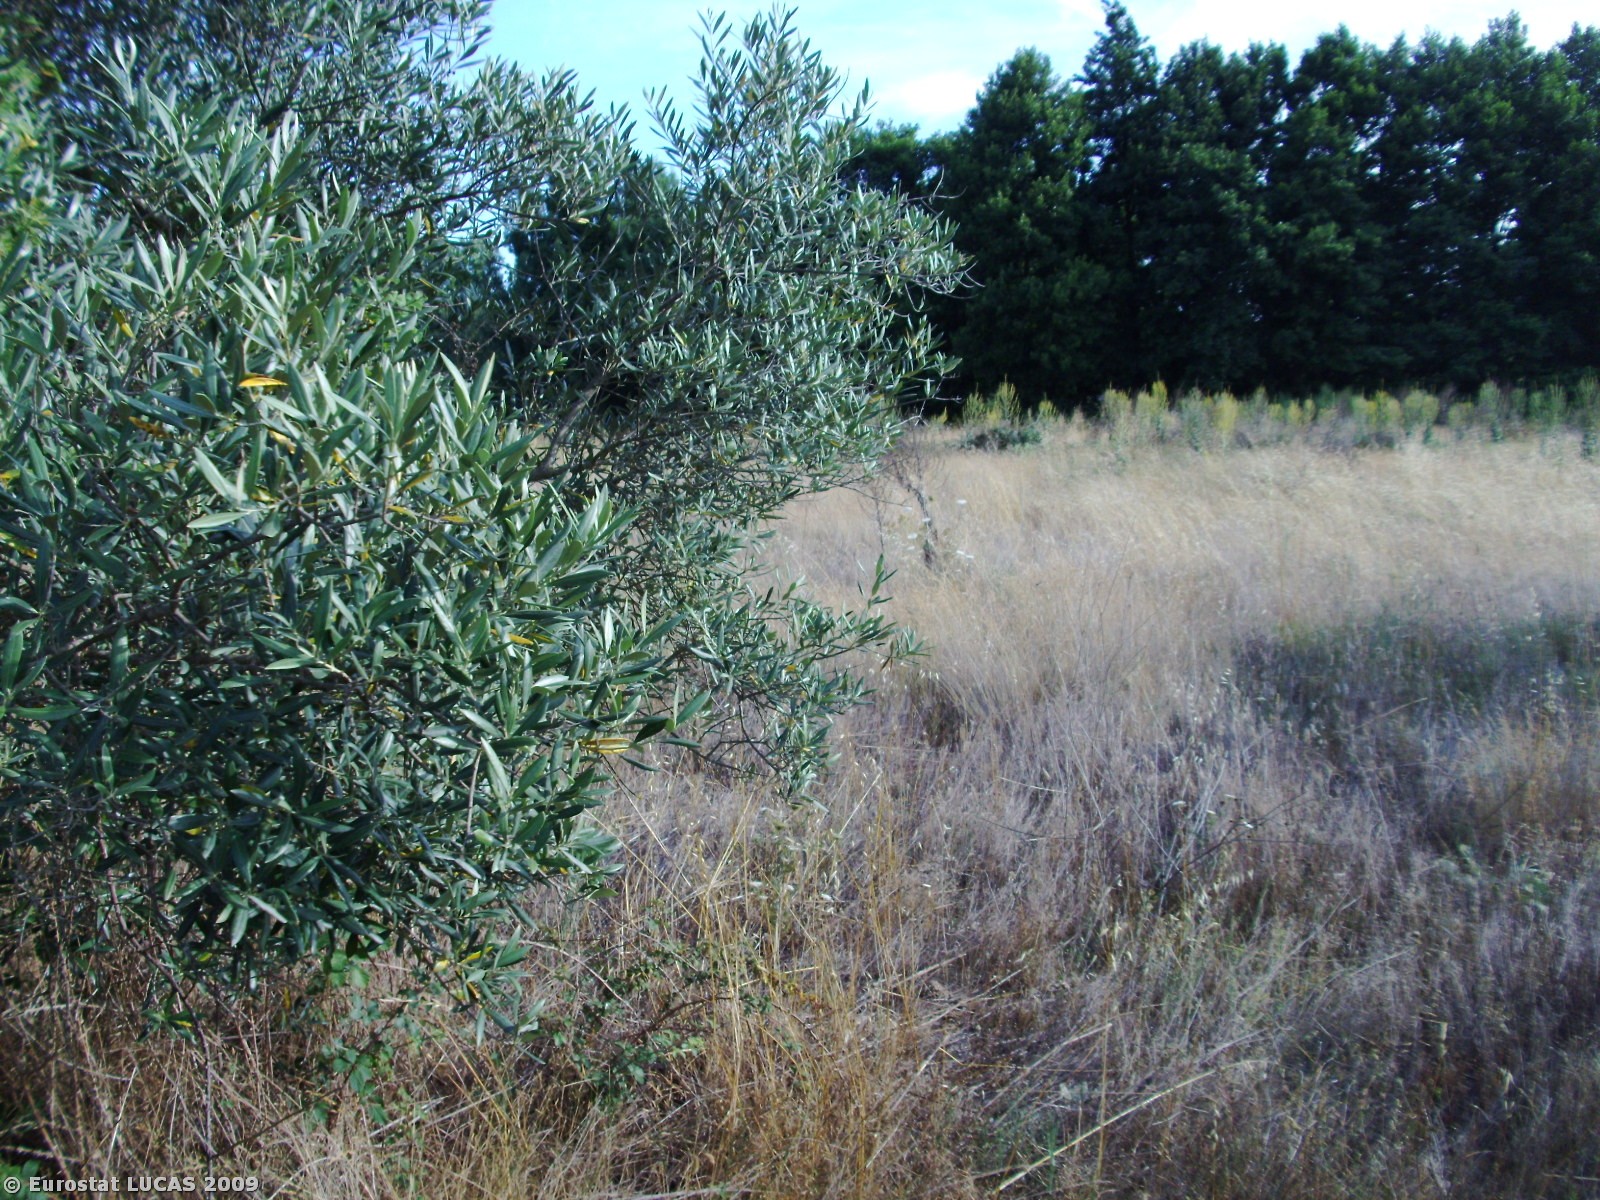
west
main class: Cropland
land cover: Olive groves
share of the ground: 10 - 25 %
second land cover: Spontaneously vegetated surfaces
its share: > 75 %
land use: Agriculture (excluding fallow land and kitchen gardens)
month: July
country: PT
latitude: 40.2296
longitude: -7.1993
